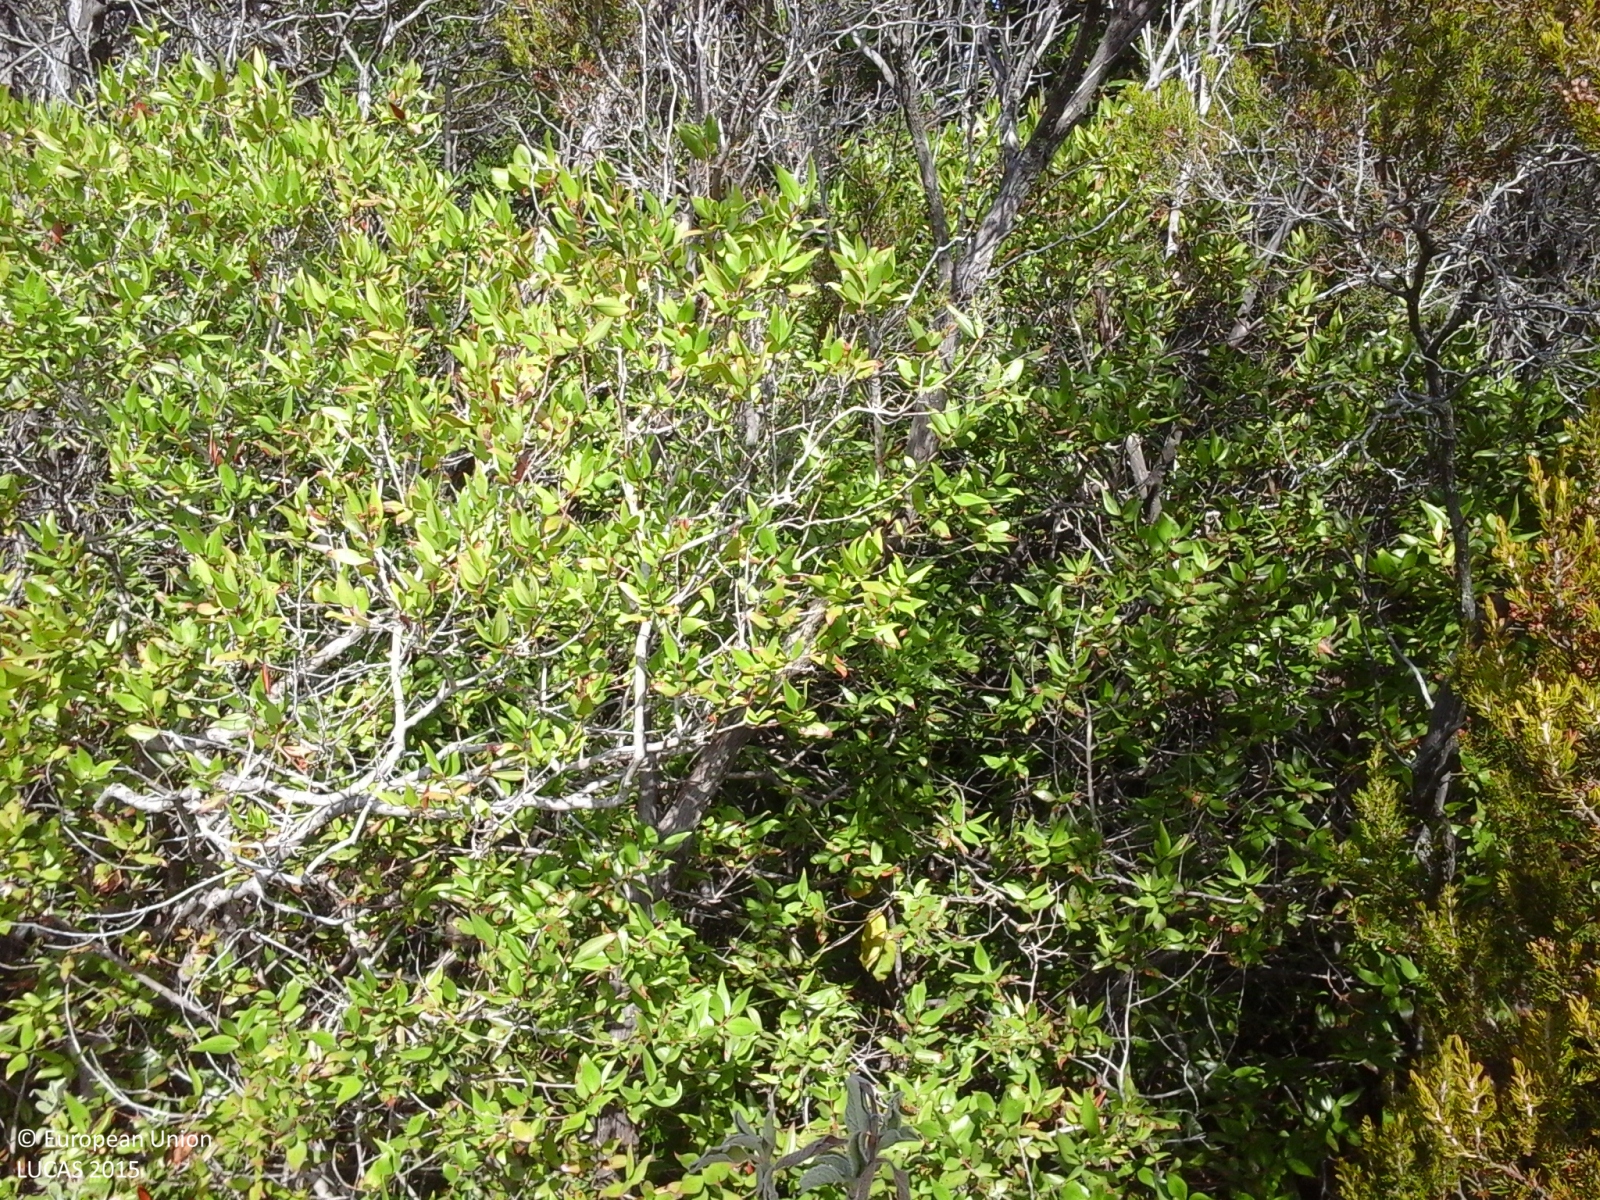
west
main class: Woodland
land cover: Other mixed woodland
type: broadleaved evergreen forest
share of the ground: > 75 %
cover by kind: broadleaved forest trees 75 %, coniferous forest trees 25 %
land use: Semi-natural and natural areas not in use
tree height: < 5 m
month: July
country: IT
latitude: 42.7982
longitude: 10.2559
